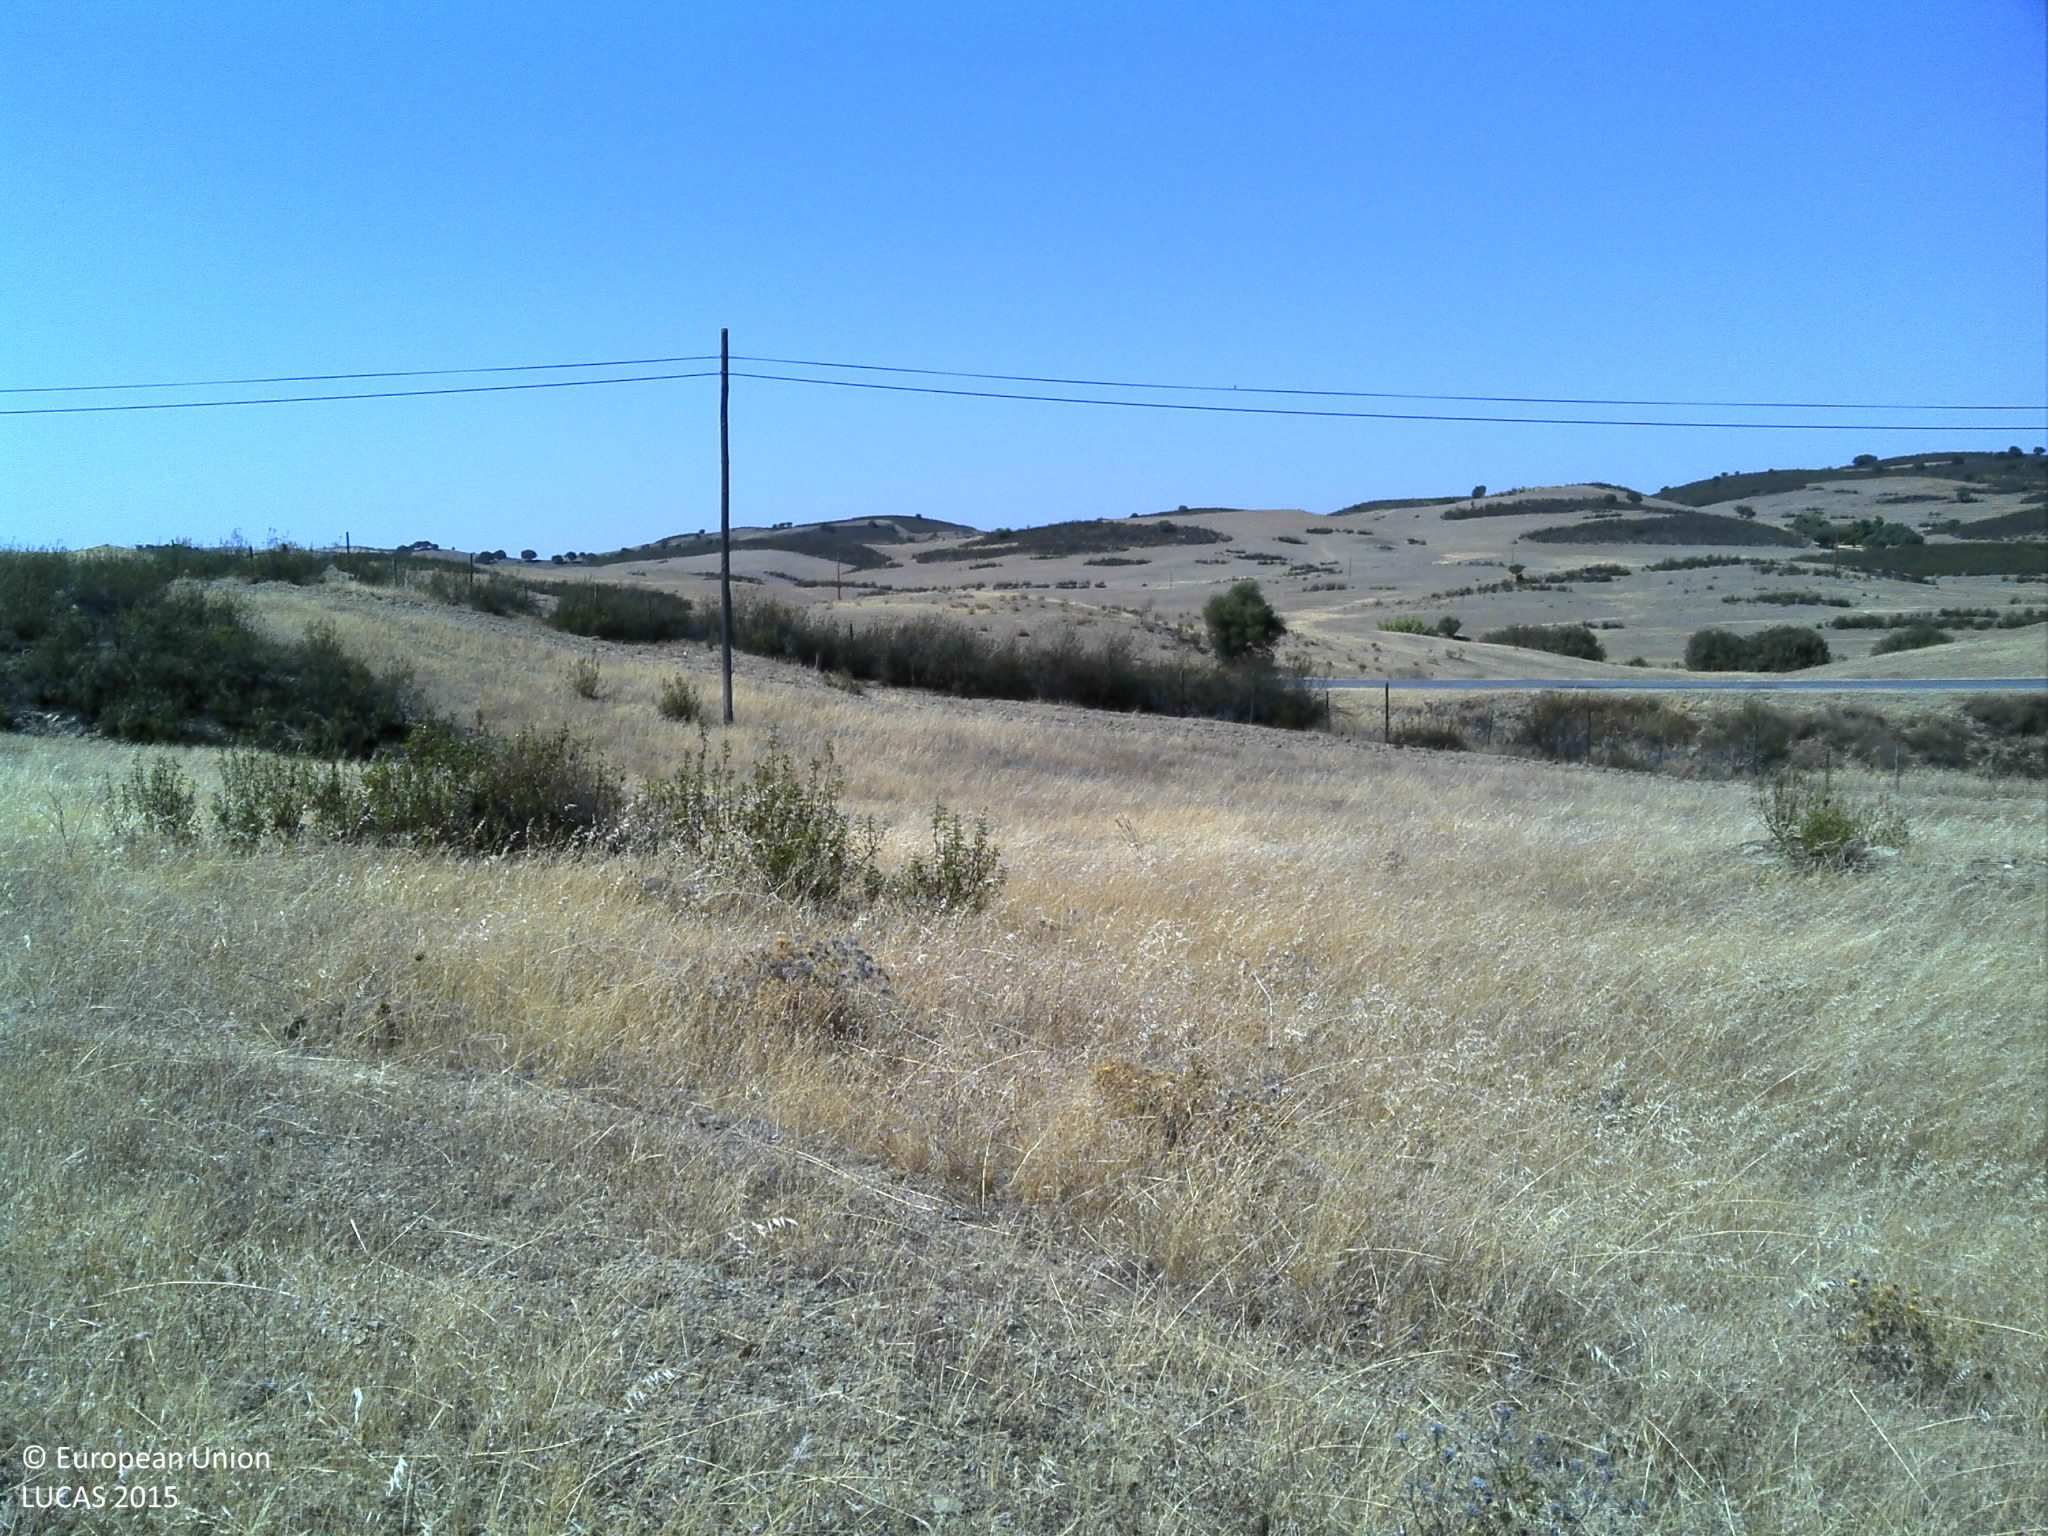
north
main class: Grassland
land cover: Grassland without tree/shrub cover
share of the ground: > 75 %
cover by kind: herbaceous plants 90 %, unconsolidated bare surface 10 %
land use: Agriculture (excluding fallow land and kitchen gardens)
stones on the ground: < 10 %
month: July
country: PT
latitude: 37.5567
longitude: -7.7777
